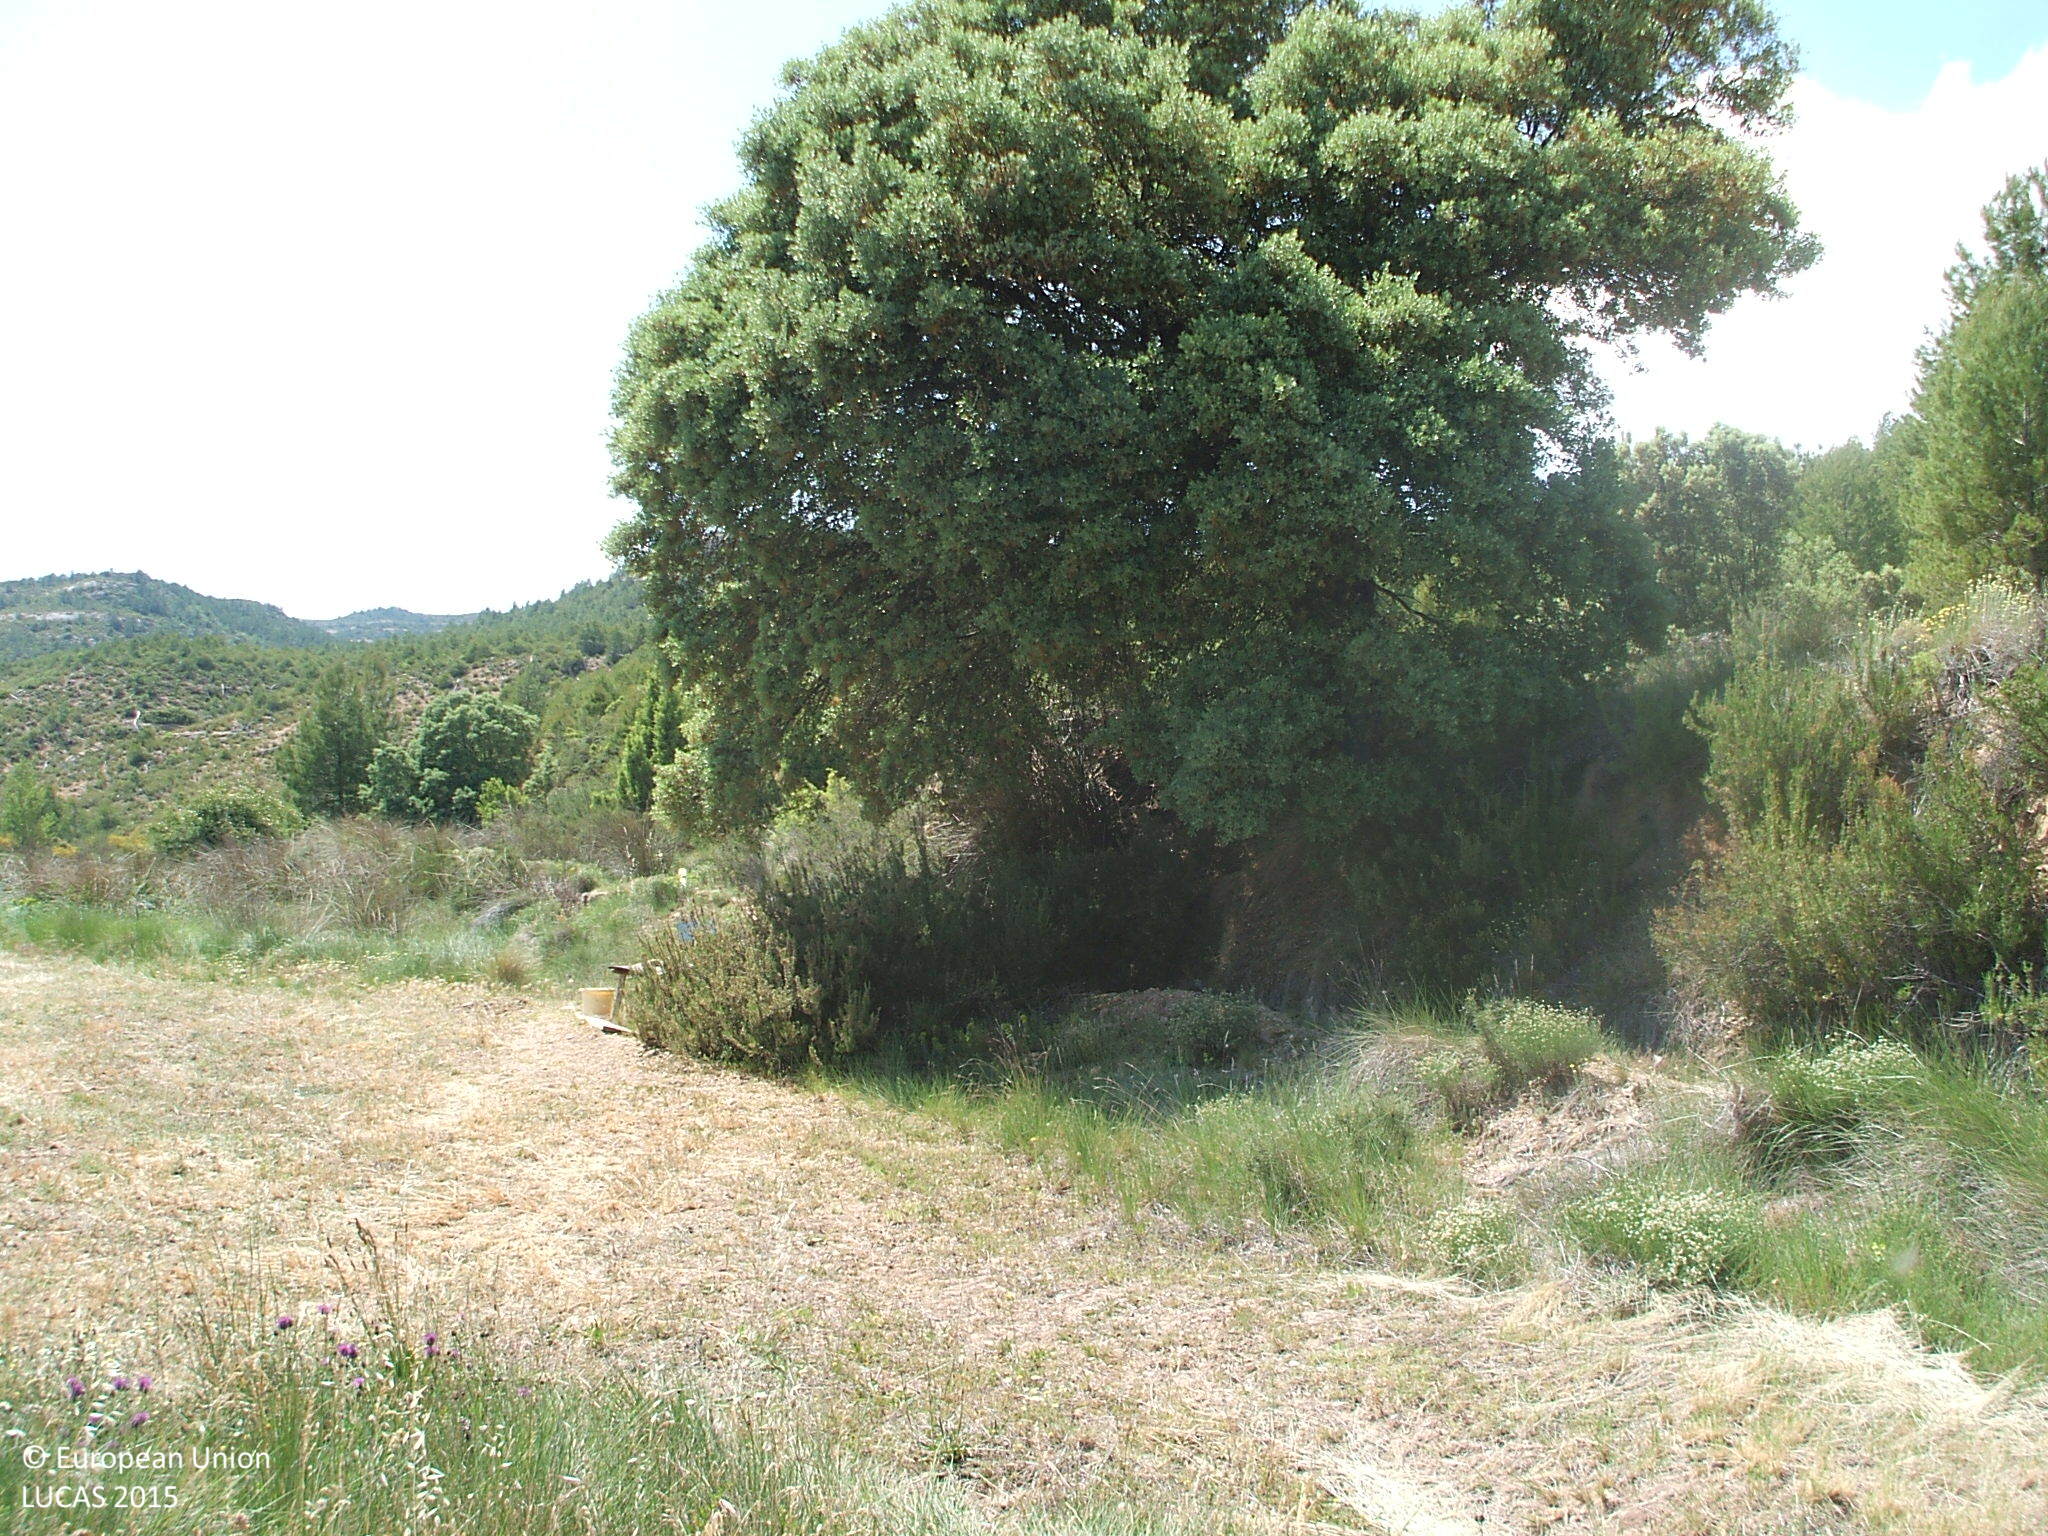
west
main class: Cropland
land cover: Oats
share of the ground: < 10 %
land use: Agriculture (excluding fallow land and kitchen gardens)
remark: Harvested field
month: May
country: ES
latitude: 40.7180
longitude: -0.2014
